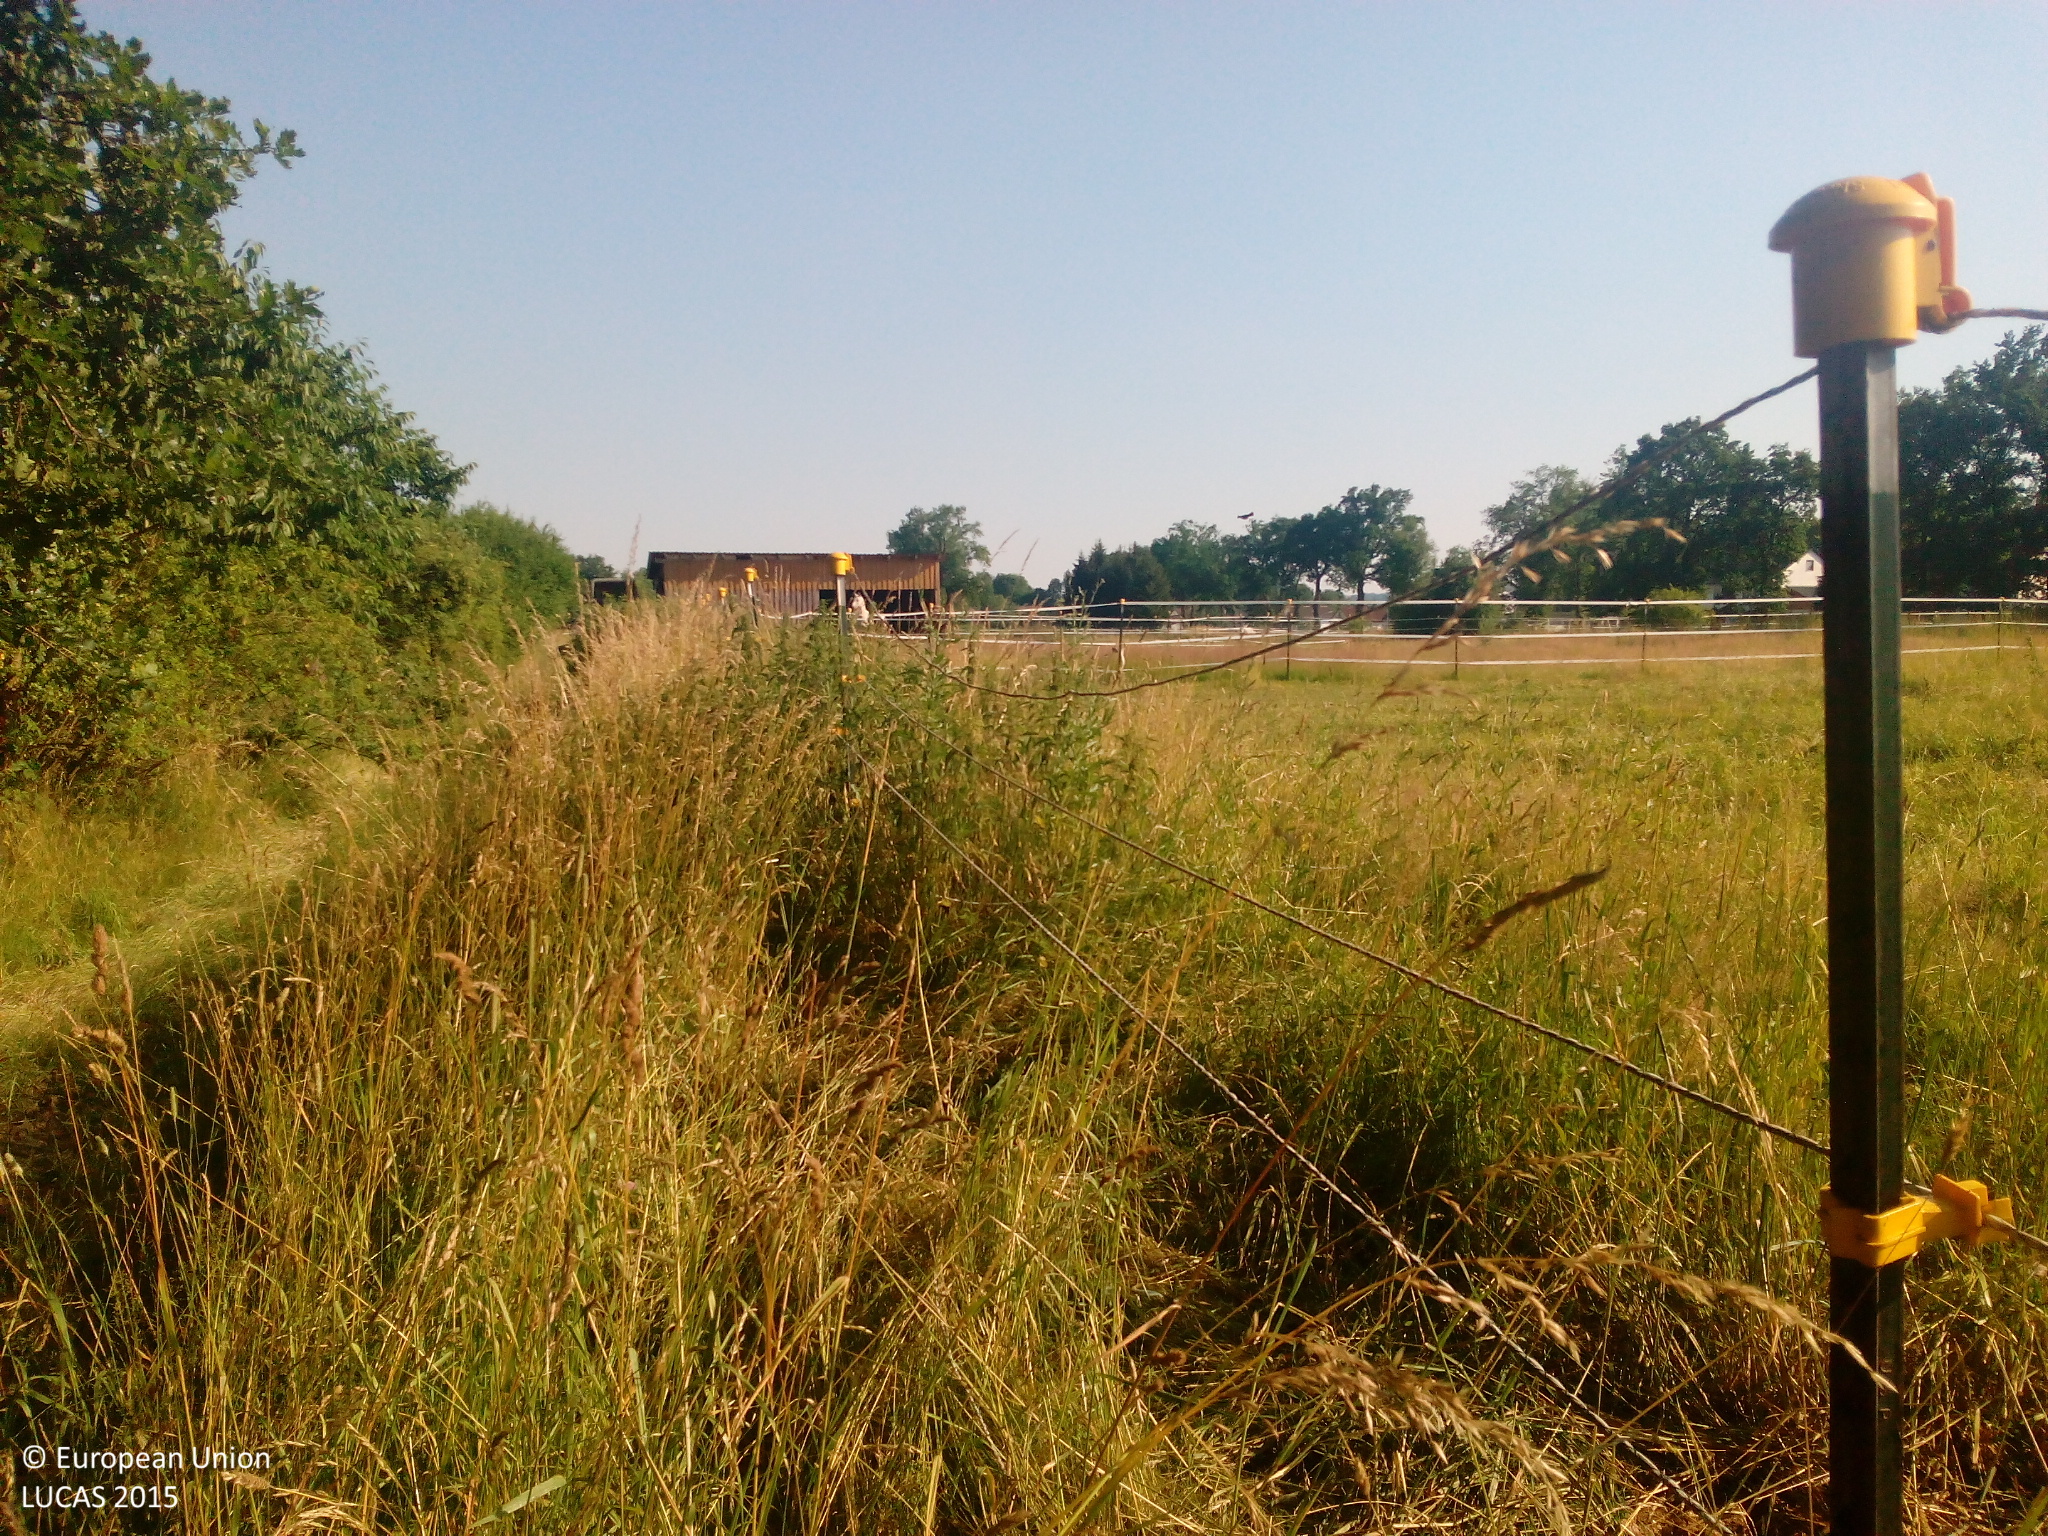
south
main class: Grassland
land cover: Grassland without tree/shrub cover
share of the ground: > 75 %
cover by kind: herbaceous plants 100 %
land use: Agriculture (excluding fallow land and kitchen gardens)
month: July
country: DE
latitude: 50.1014
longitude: 11.5794
